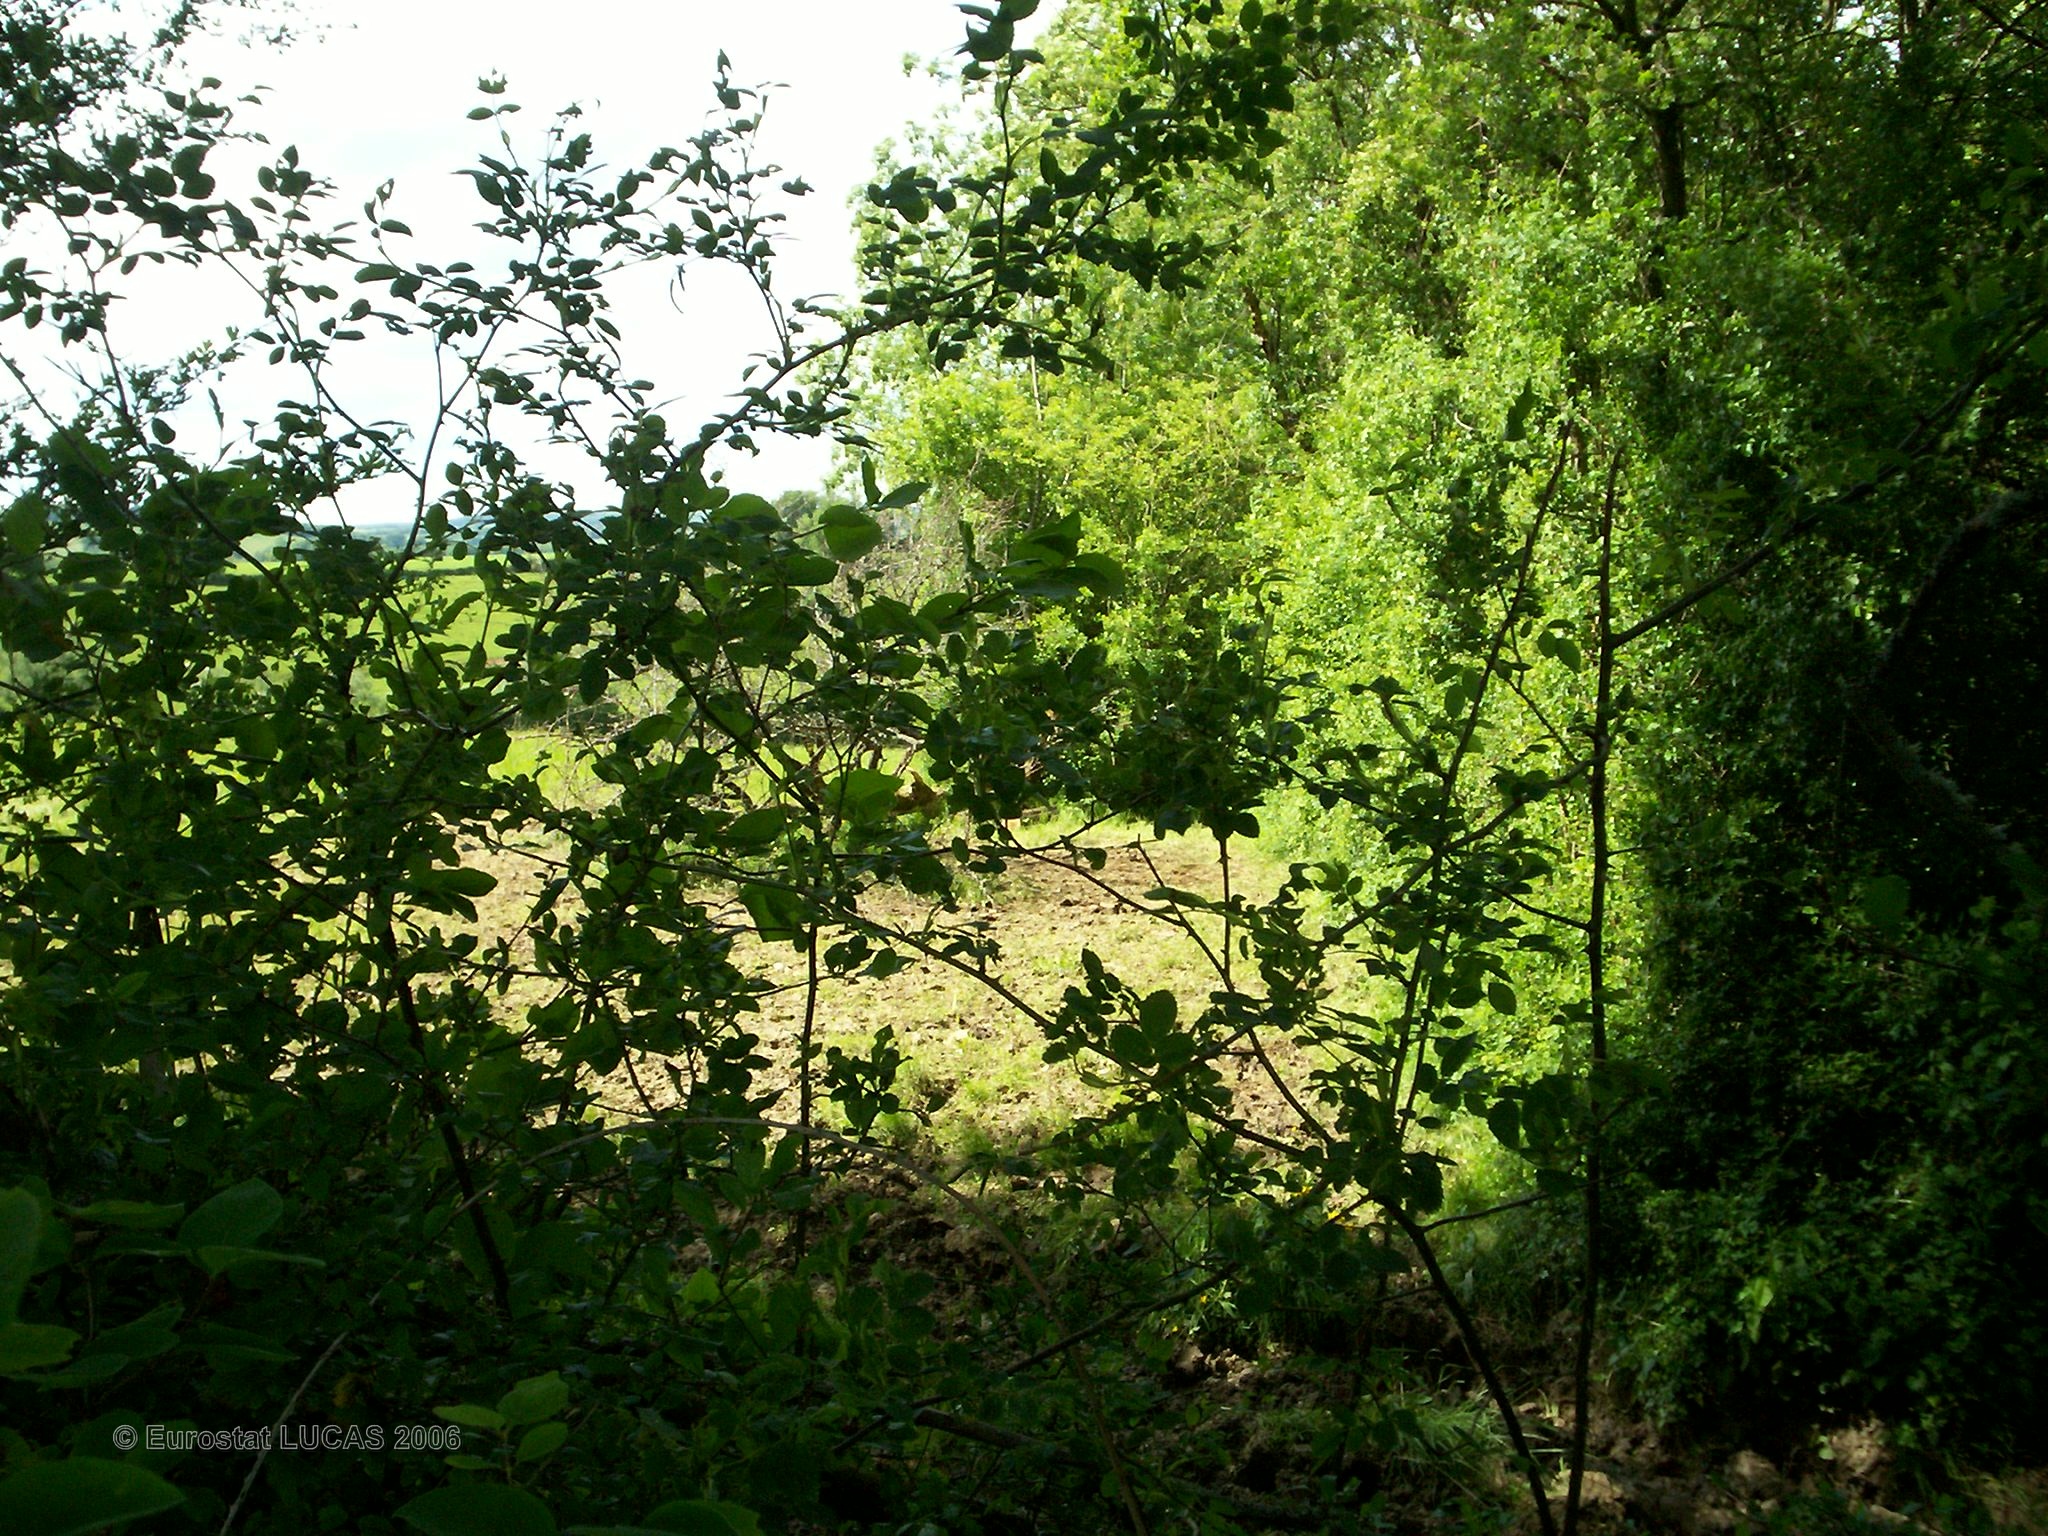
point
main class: Grassland
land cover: Grassland without tree/shrub cover
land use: Agriculture (excluding fallow land and kitchen gardens)
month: May
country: FR
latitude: 47.5371
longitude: 4.0064
